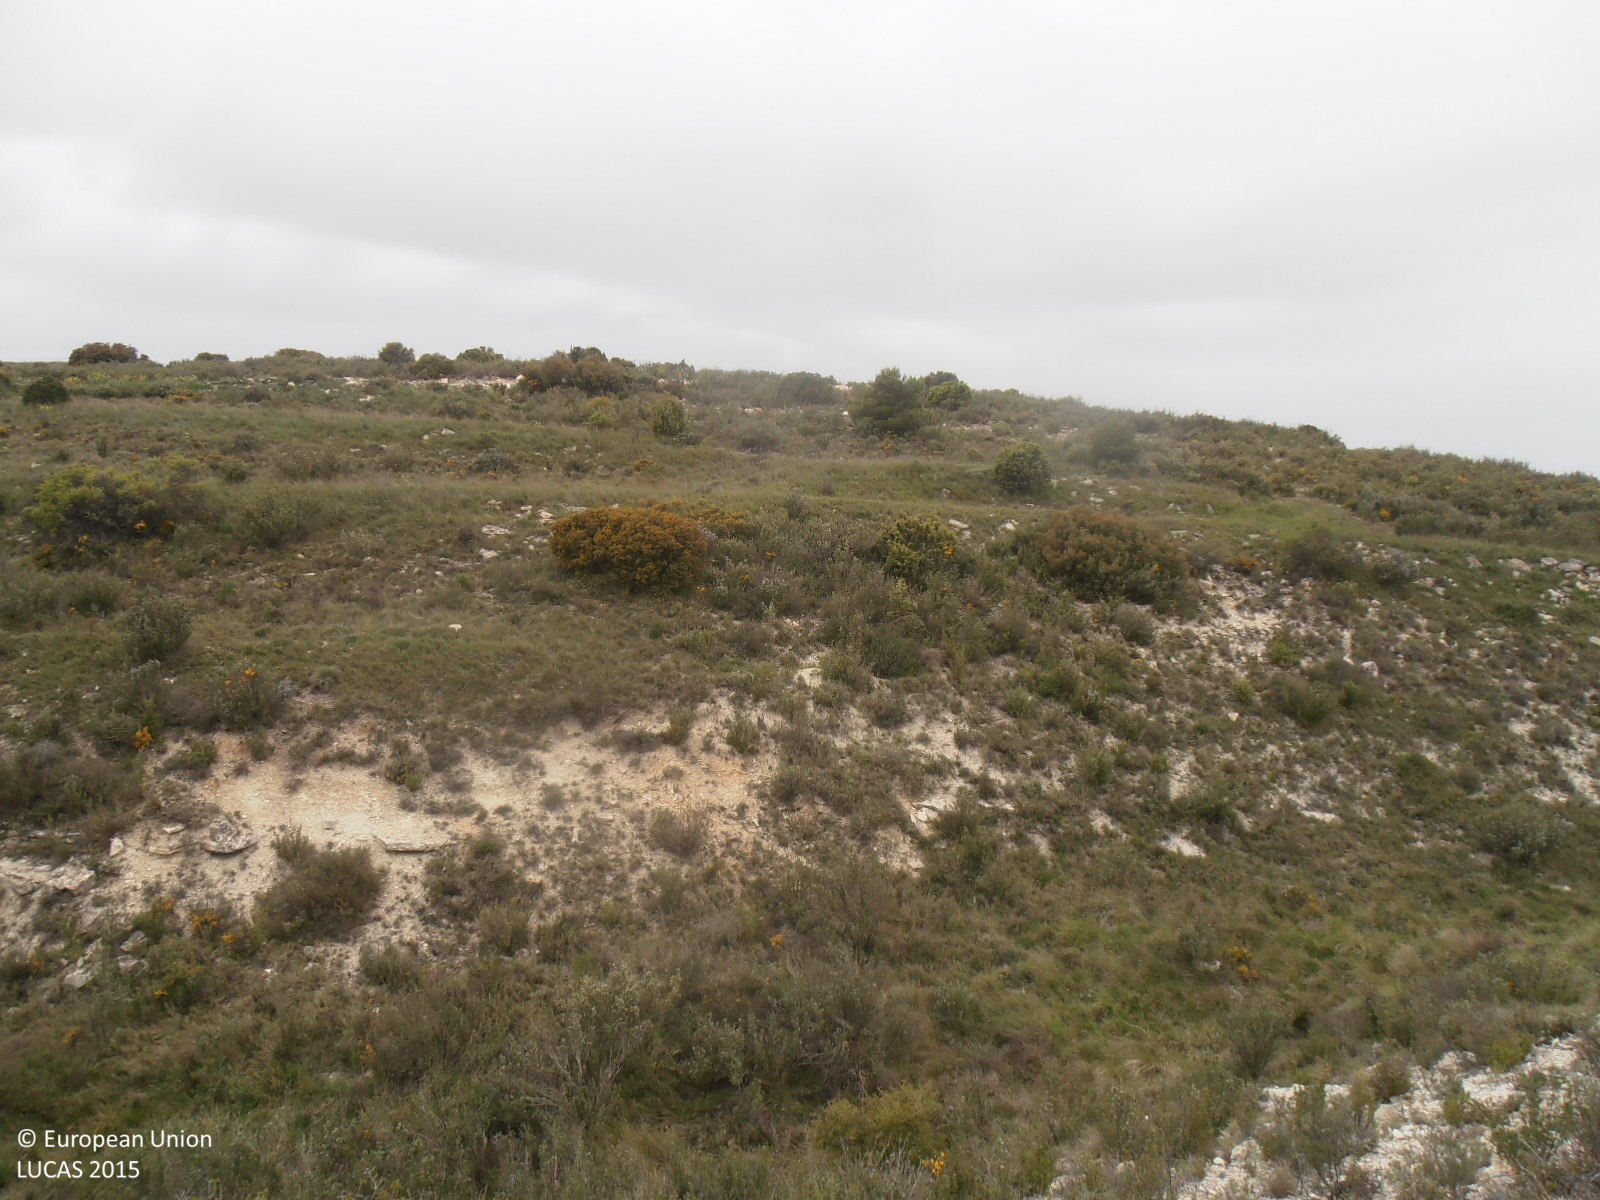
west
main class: Shrubland
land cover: Shrubland without tree cover
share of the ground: > 75 %
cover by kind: shrubs 65 %, consolidated bare surface 25 %, herbaceous plants 10 %
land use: Semi-natural and natural areas not in use
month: May
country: ES
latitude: 41.4164
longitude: -0.9915
